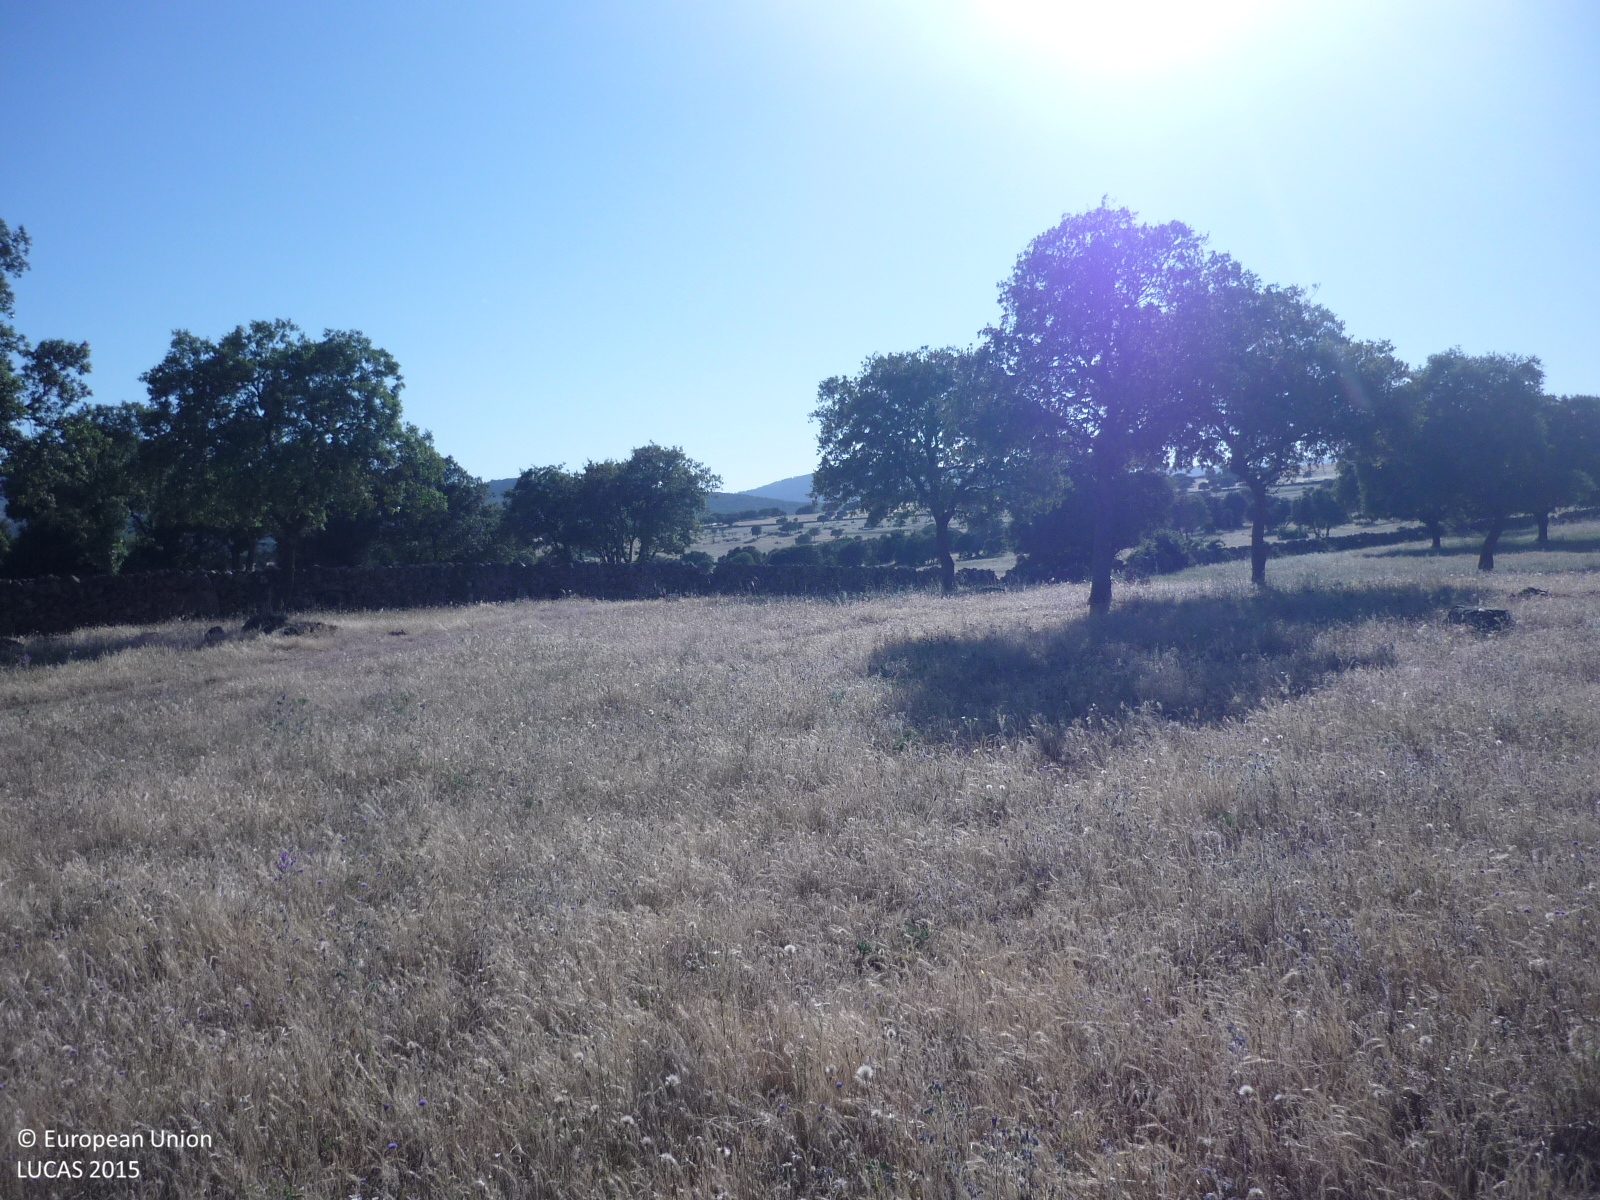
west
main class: Grassland
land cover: Grassland with sparse tree/shrub cover
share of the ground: > 75 %
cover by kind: herbaceous plants 90 %, broadleaved forest trees 5 %, shrubs 5 %
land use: Agriculture (excluding fallow land and kitchen gardens)
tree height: < 5 m
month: May
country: ES
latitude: 40.6869
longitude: -3.8758
